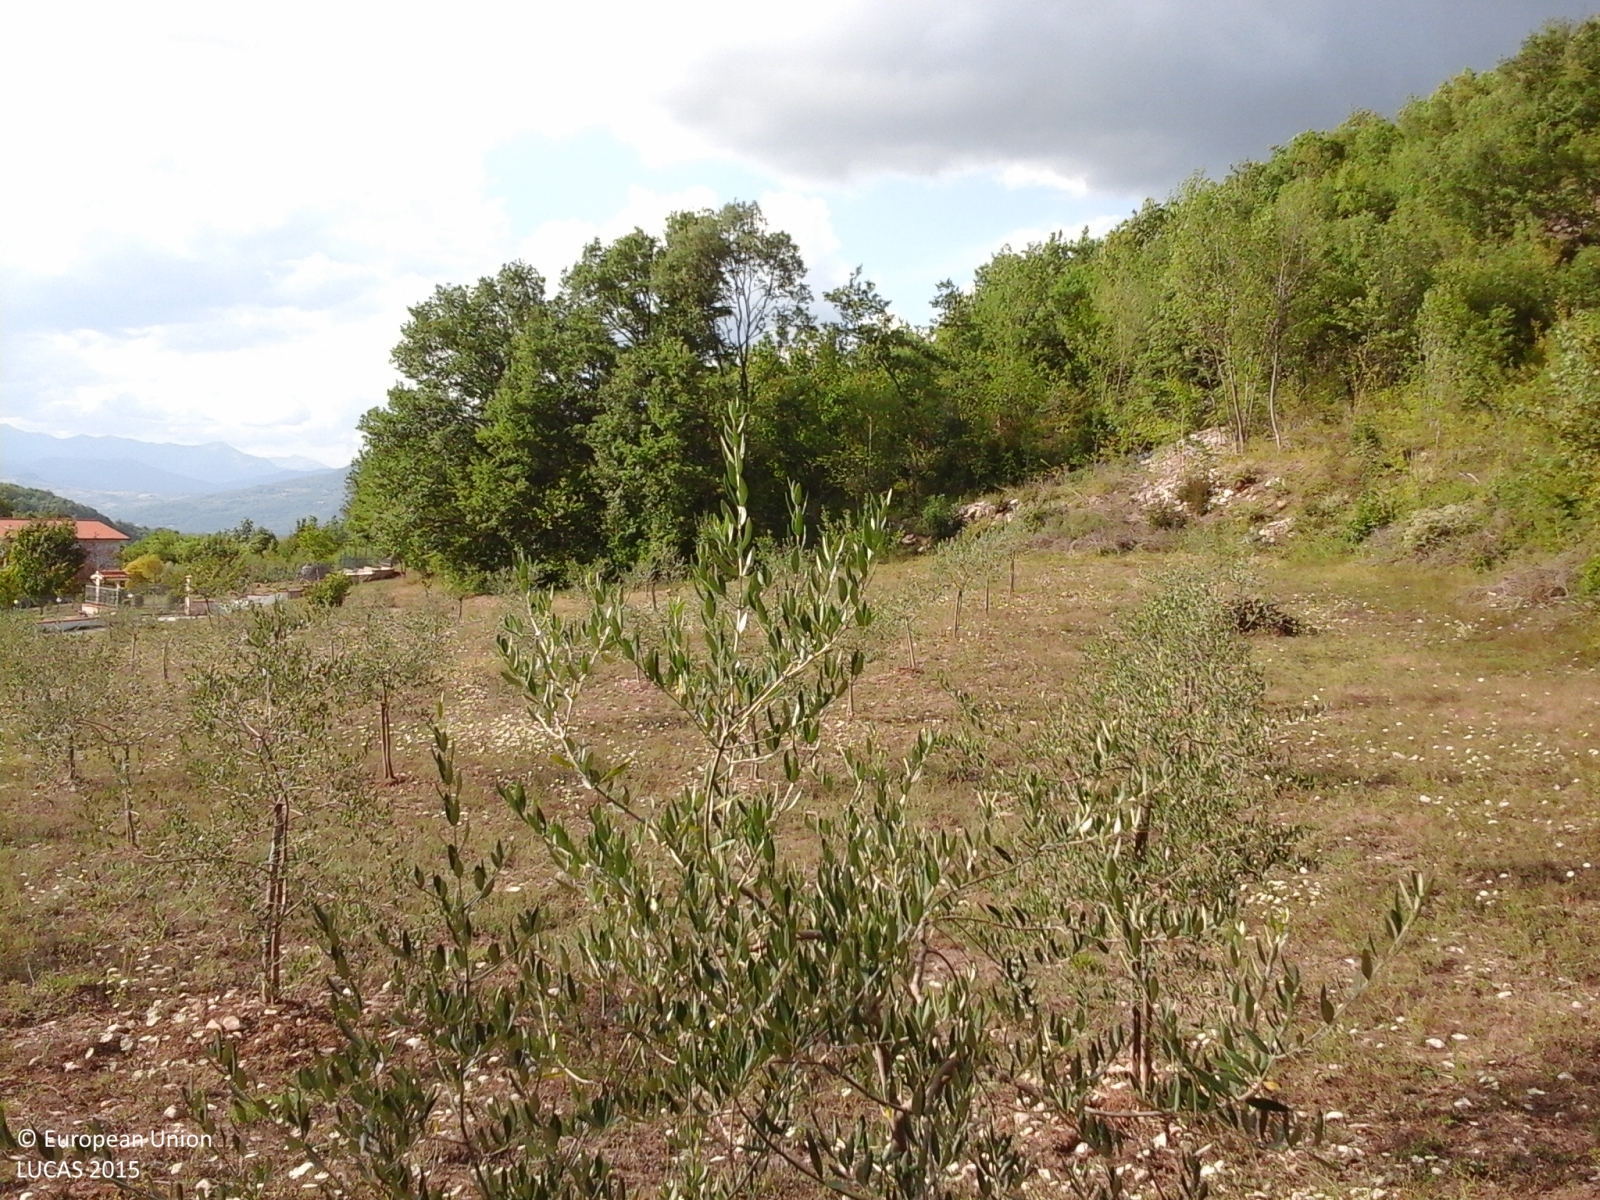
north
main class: Woodland
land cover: Broadleaved woodland
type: thermophilous deciduous forest
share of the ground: > 75 %
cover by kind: broadleaved forest trees 85 %, shrubs 10 %, herbaceous plants 5 %
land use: Semi-natural and natural areas not in use
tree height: > 5 m
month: August
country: IT
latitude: 41.5681
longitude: 14.2897
